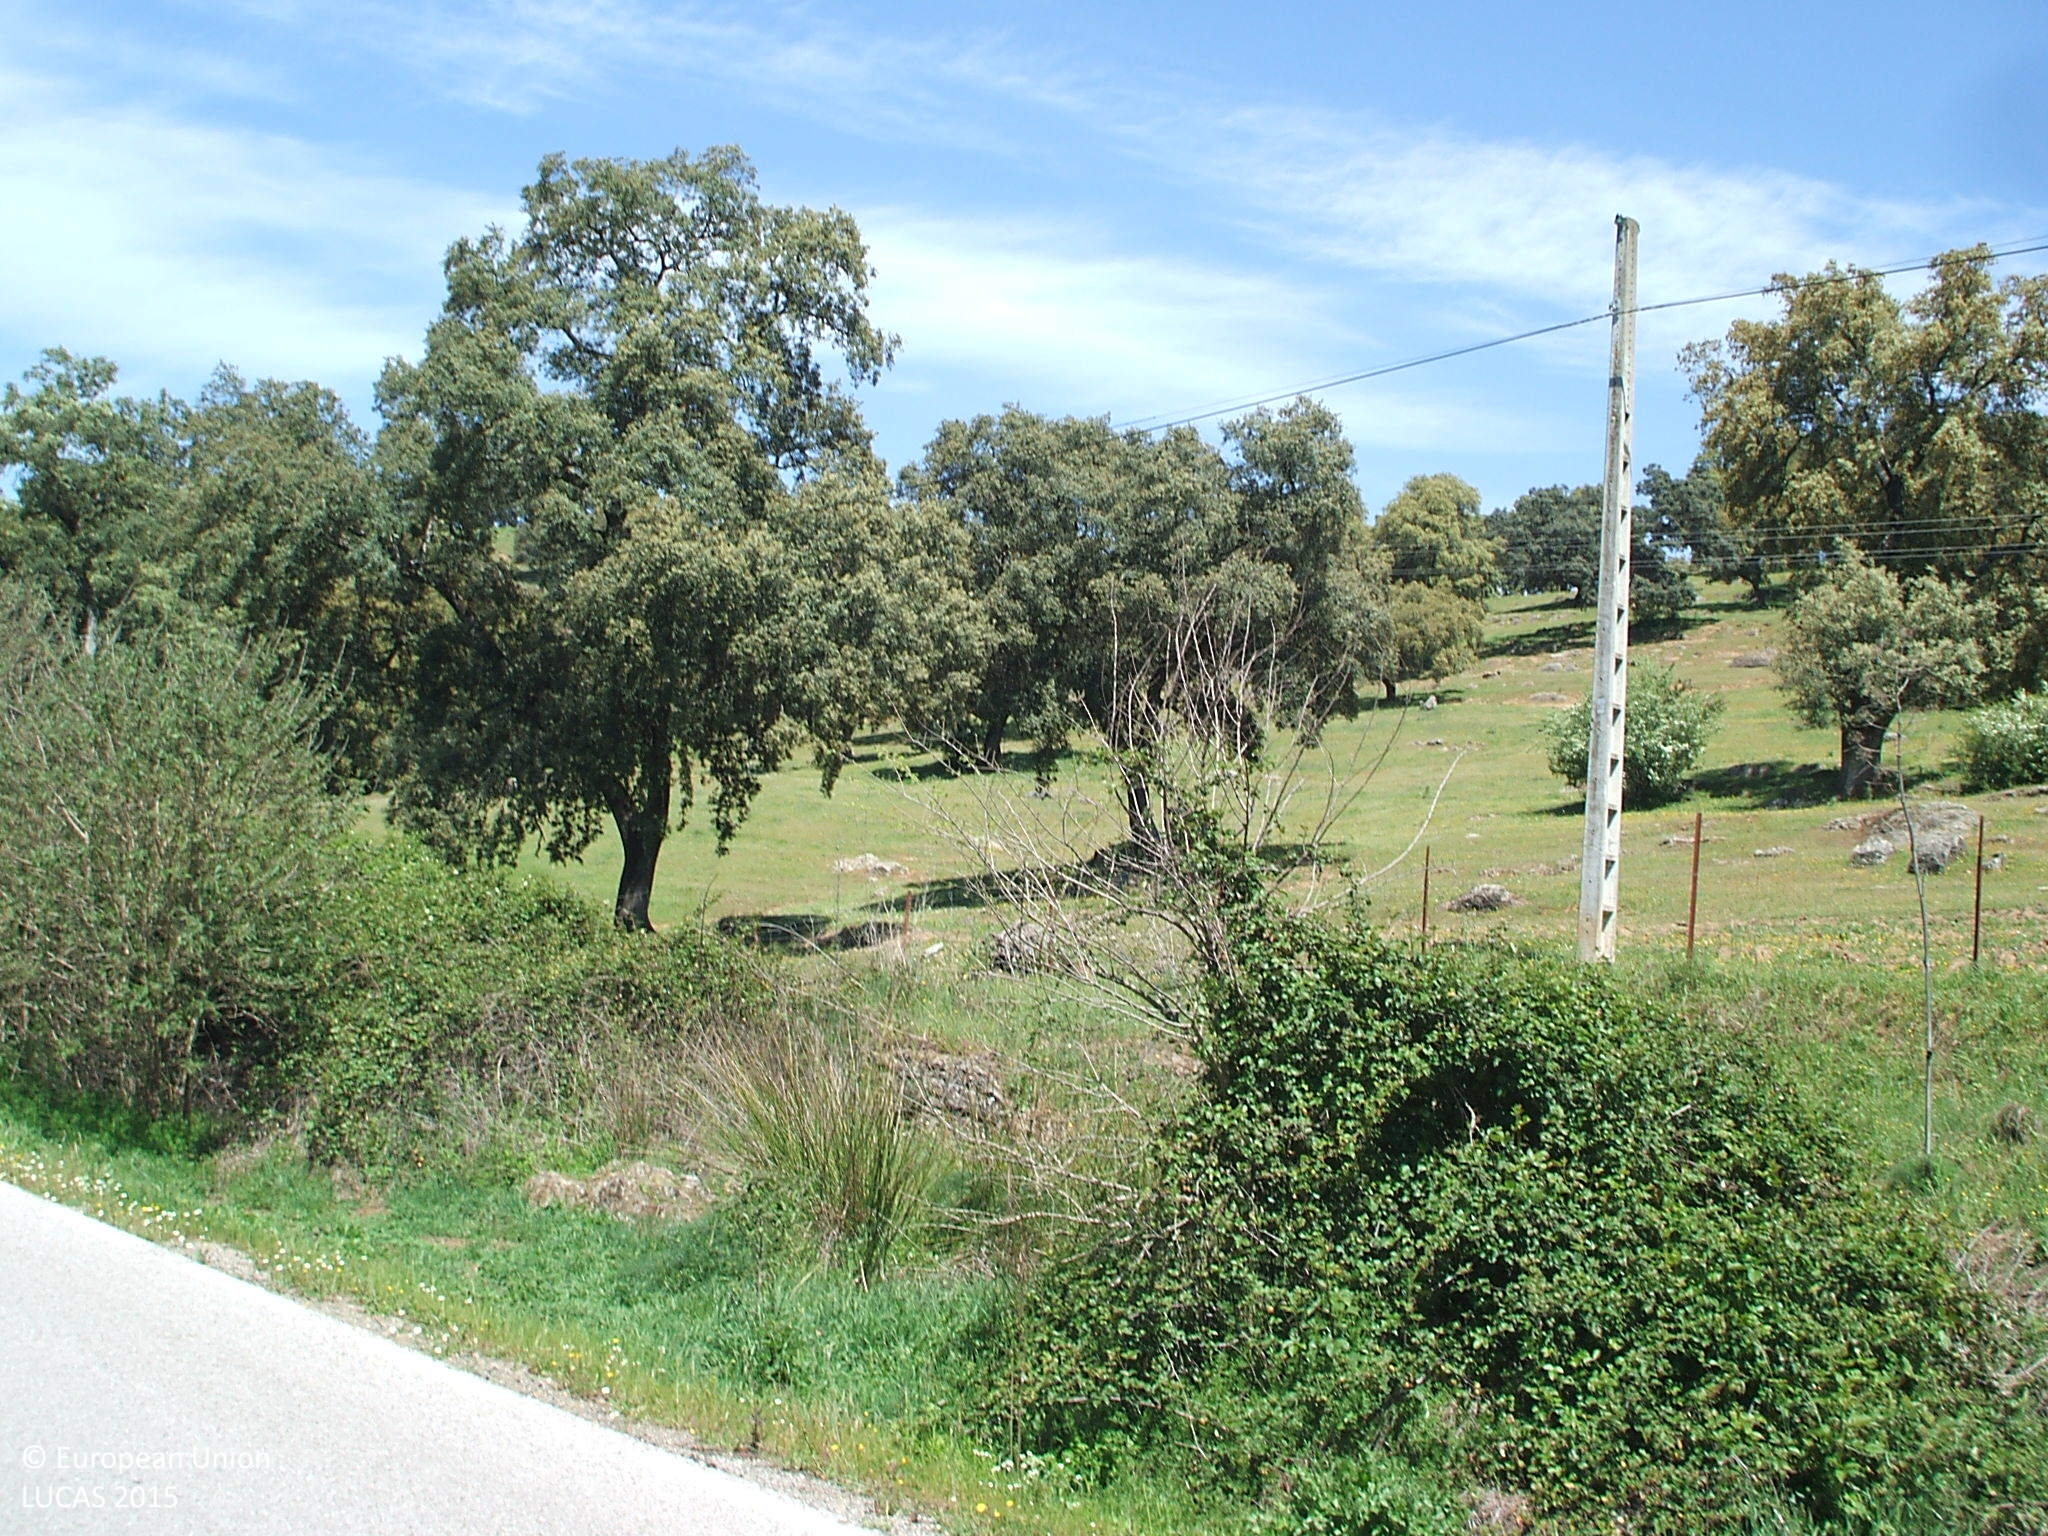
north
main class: Shrubland
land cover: Shrubland with sparse tree cover
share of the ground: > 75 %
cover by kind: shrubs 70 %, herbaceous plants 25 %, broadleaved forest trees 5 %
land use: Agriculture (excluding fallow land and kitchen gardens)
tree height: > 5 m
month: April
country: ES
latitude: 37.9279
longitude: -5.6946
